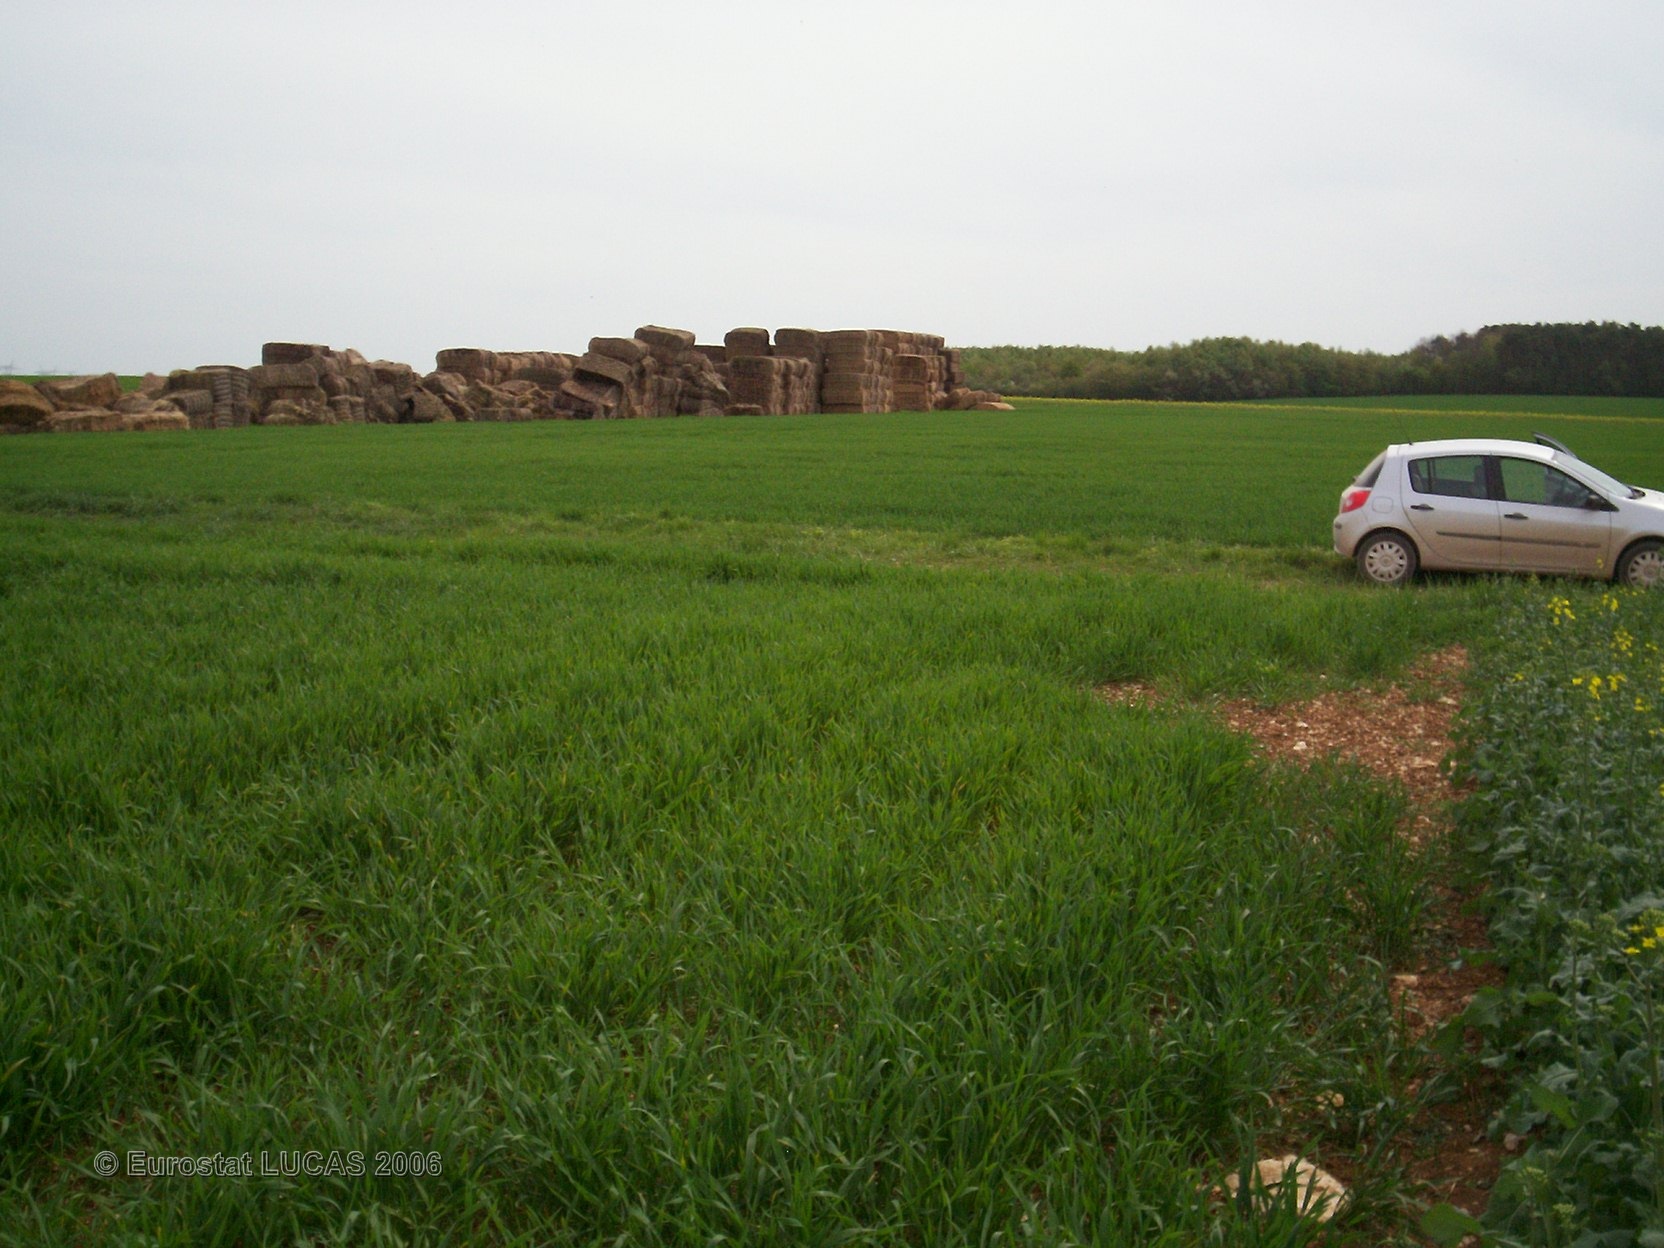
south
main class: Cropland
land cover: Rape and turnip rape
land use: Agriculture (excluding fallow land and kitchen gardens)
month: May
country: FR
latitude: 47.6547
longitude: 4.5267
